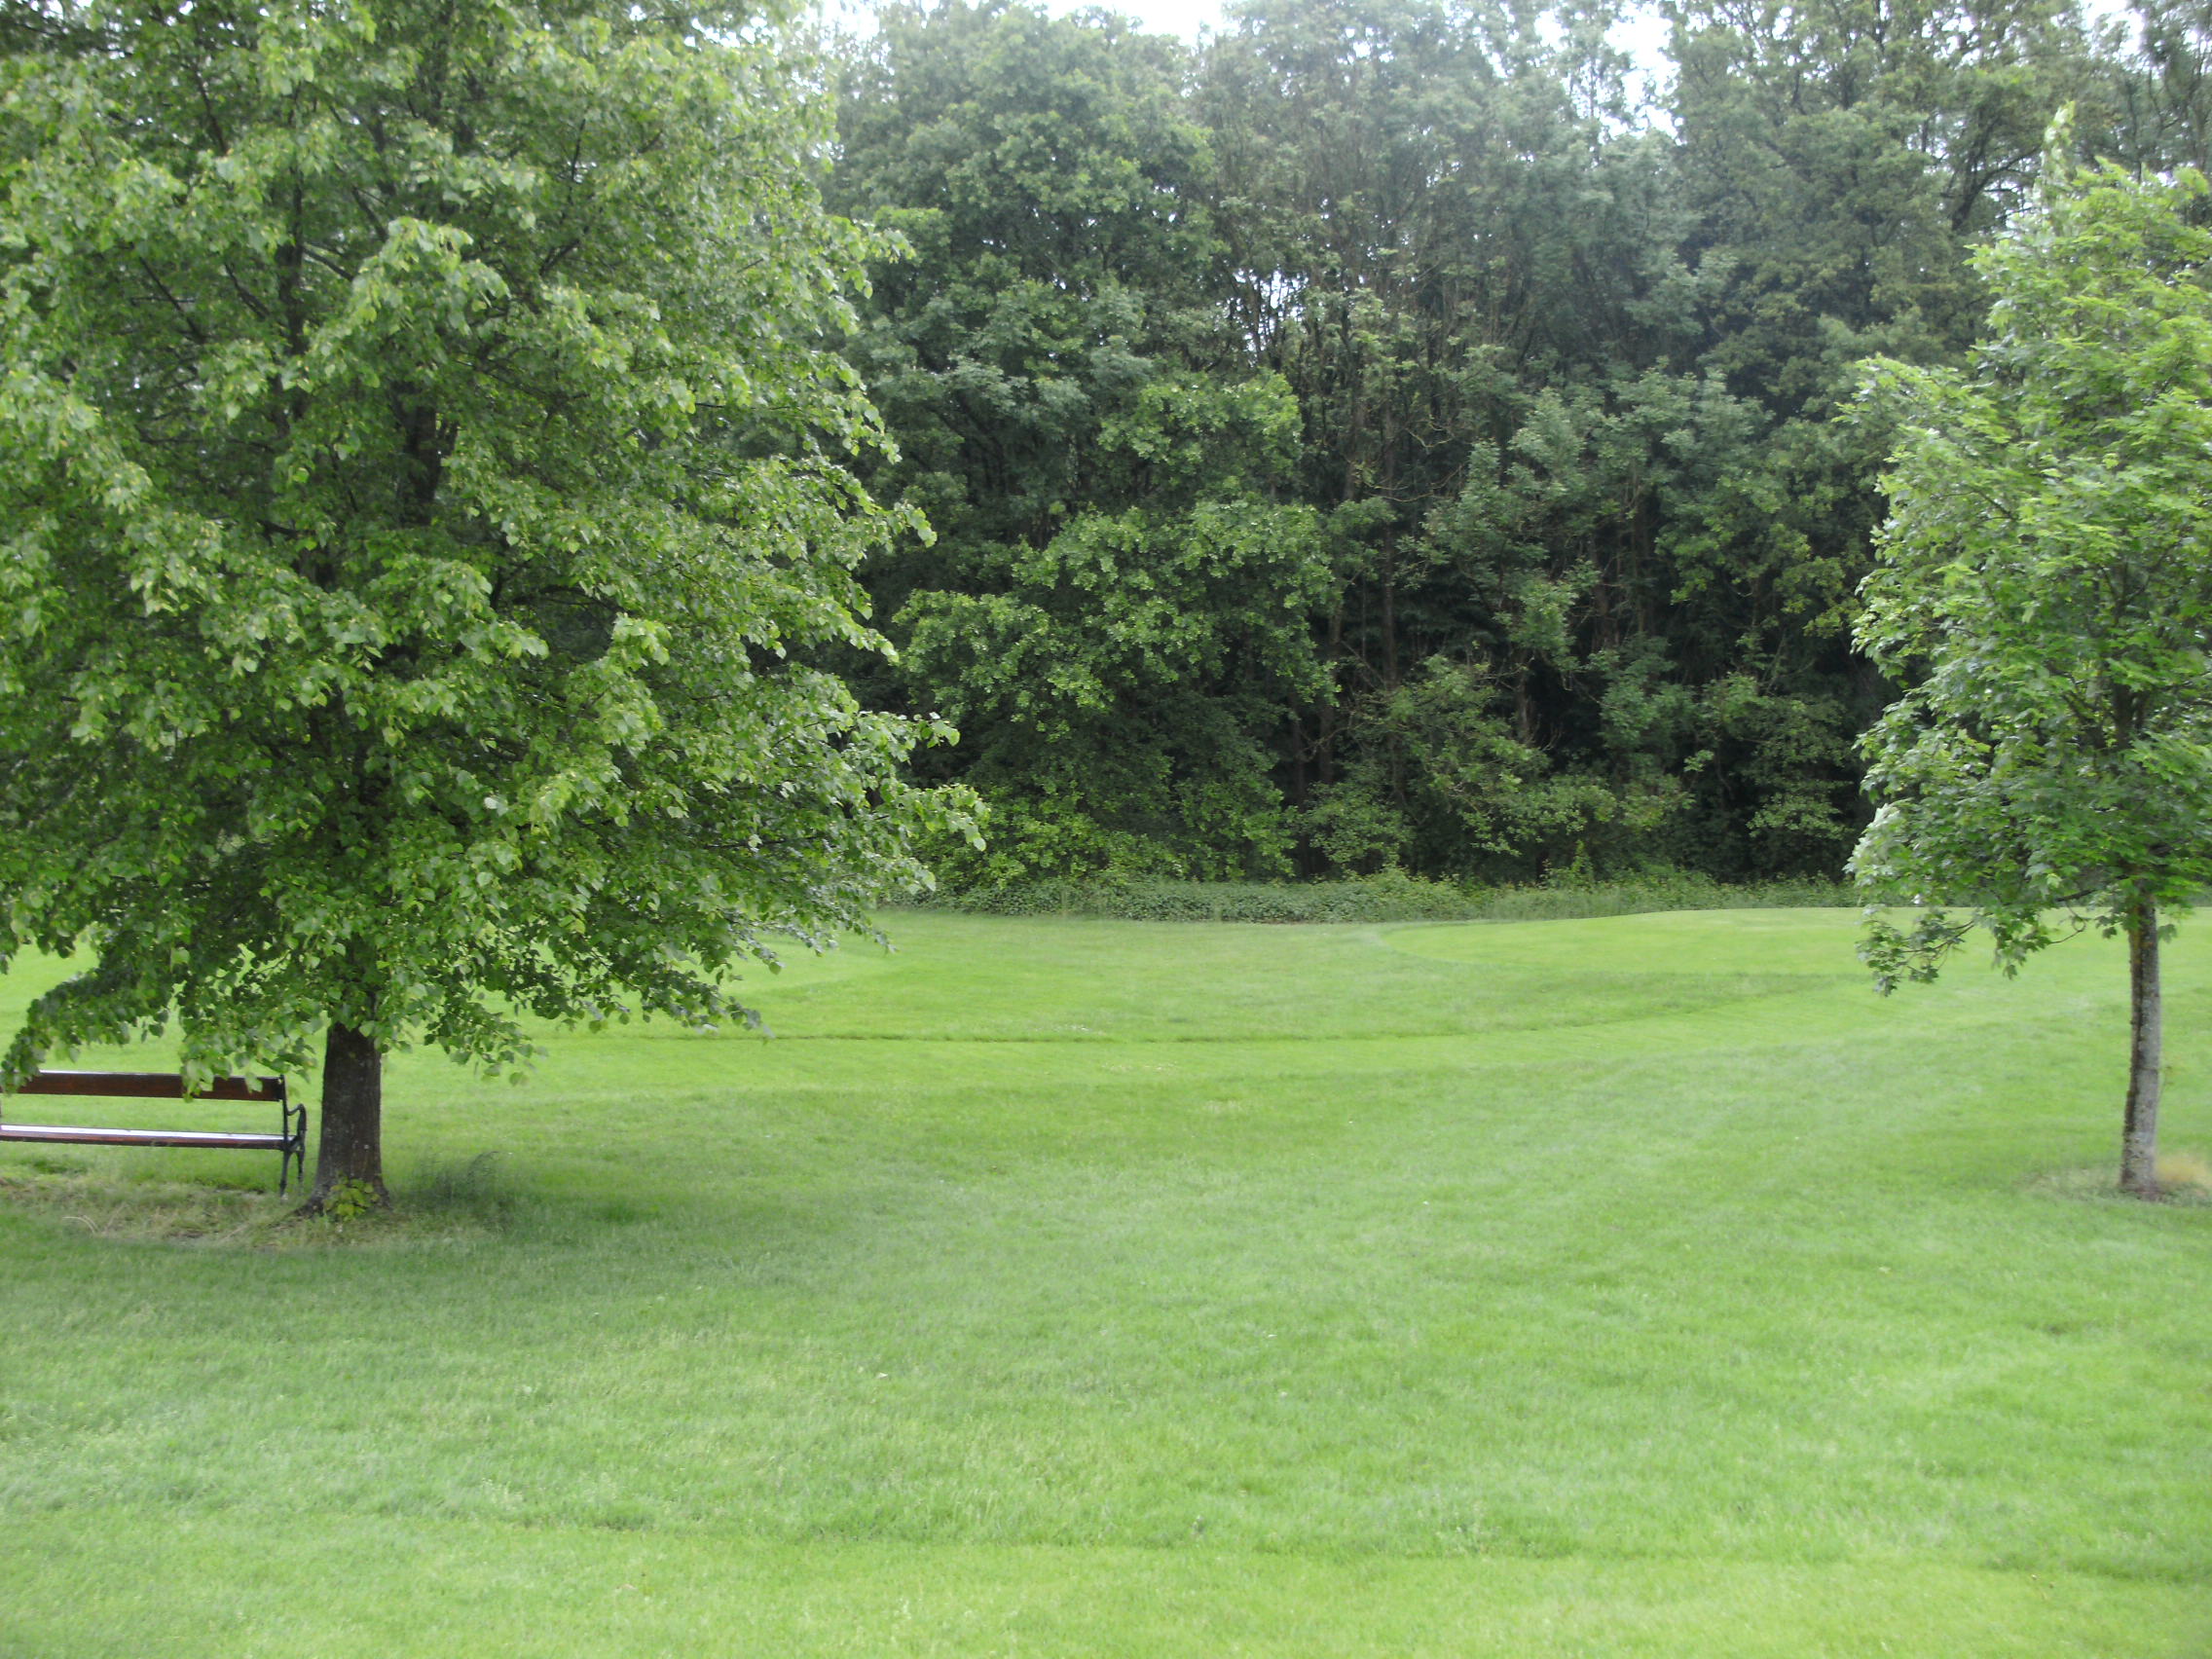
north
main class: Grassland
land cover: Grassland without tree/shrub cover
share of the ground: > 75 %
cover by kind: herbaceous plants 100 %
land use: Sport
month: May
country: AT
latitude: 48.3834
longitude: 13.5237
